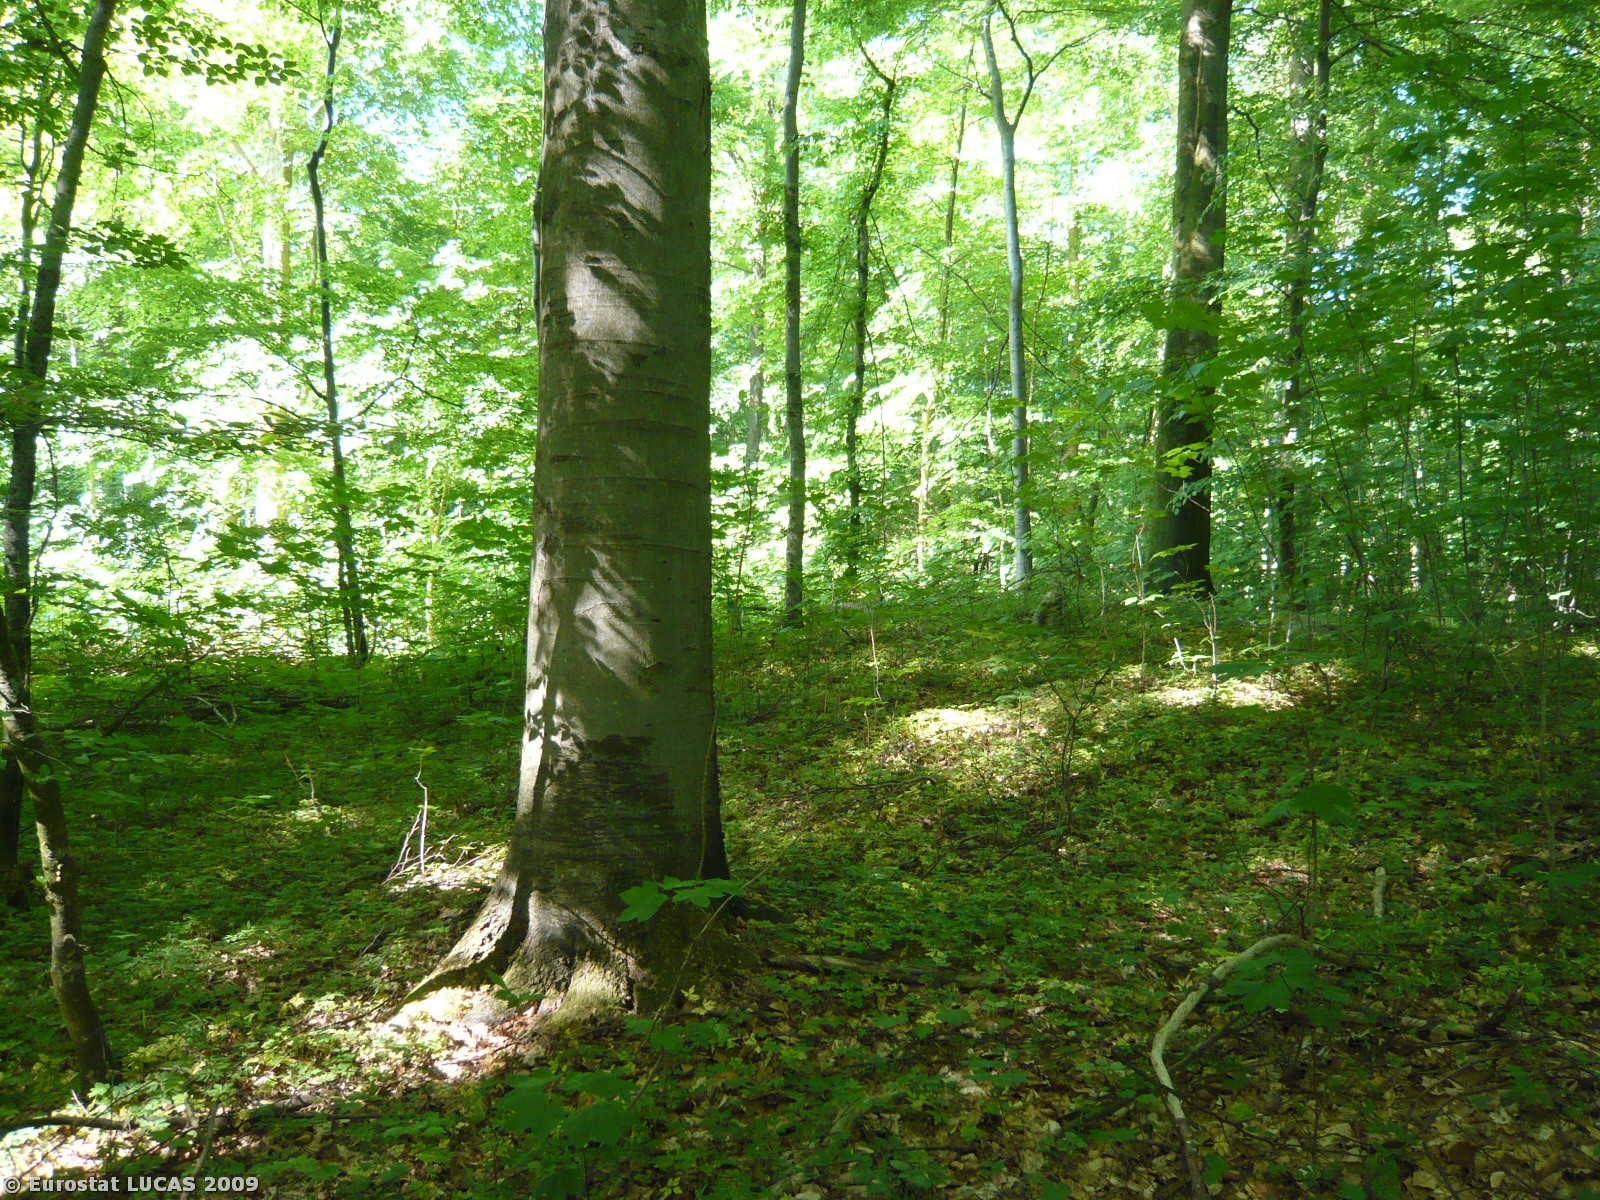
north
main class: Woodland
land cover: Broadleaved woodland
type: mesophytic deciduous forest
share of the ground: > 75 %
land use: Forestry
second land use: Amenities, museums, leisure
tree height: > 5 m
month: May
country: DK
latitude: 55.2765
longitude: 11.7774
